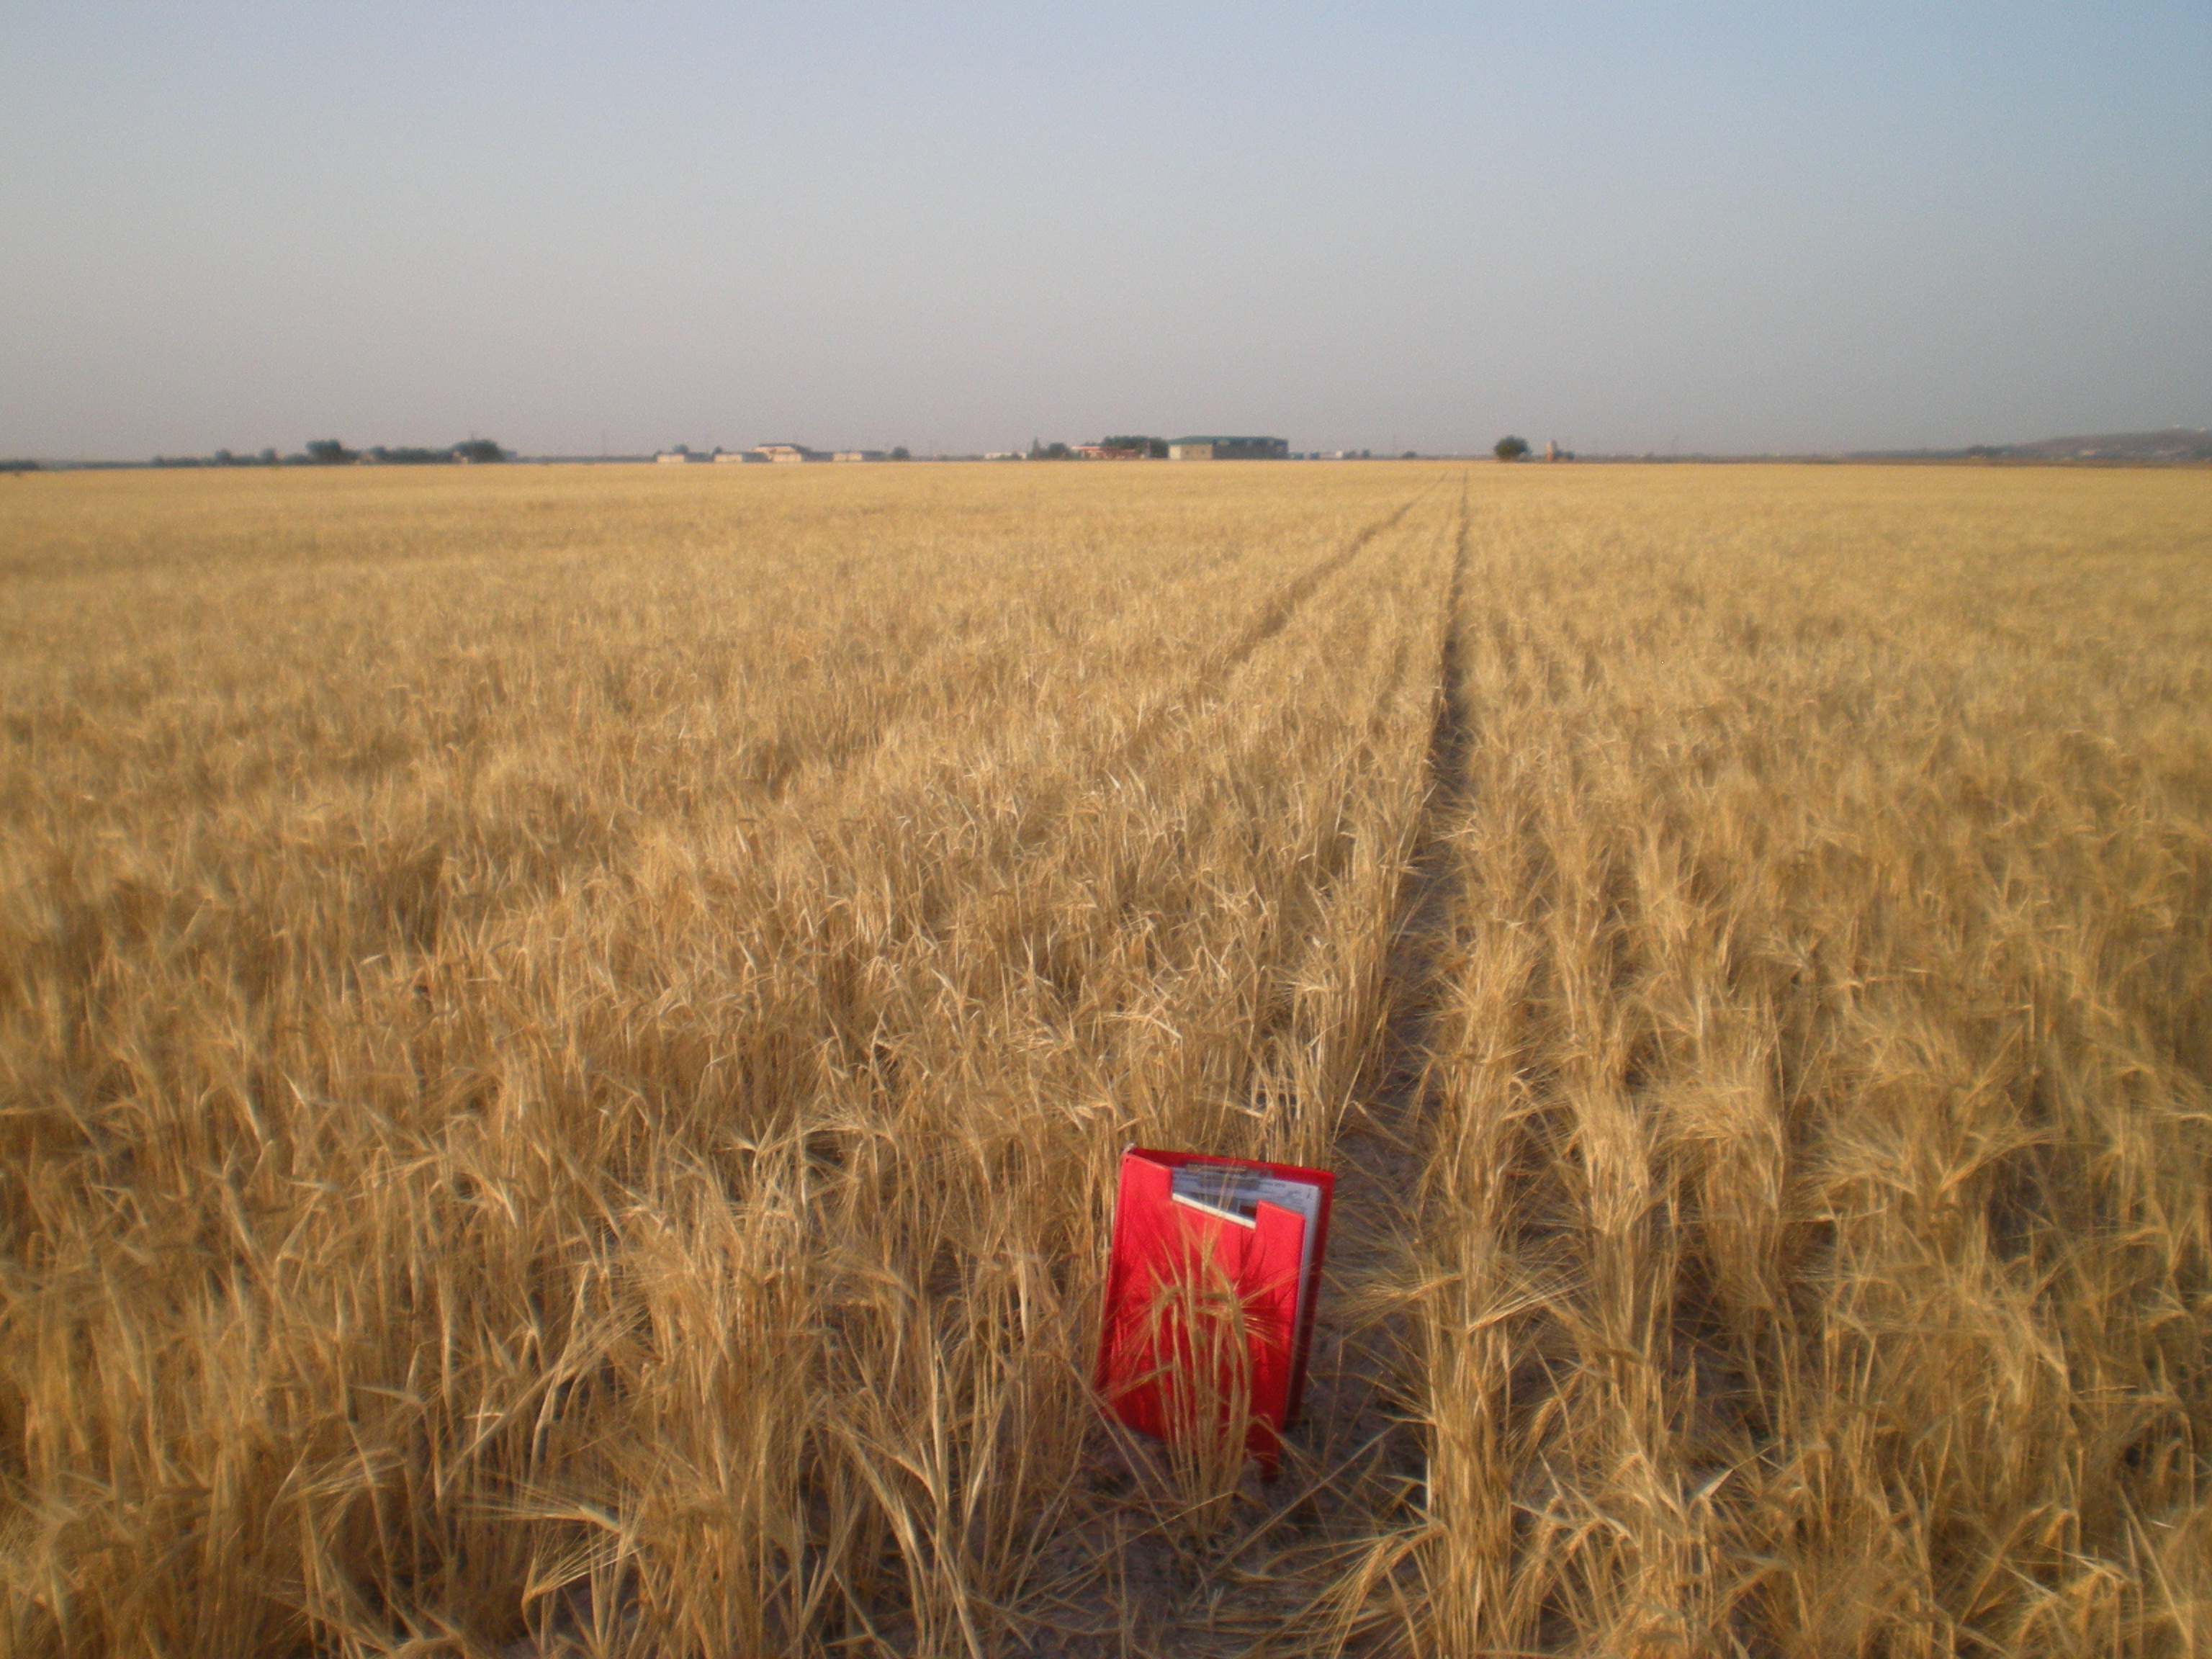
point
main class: Cropland
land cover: Barley
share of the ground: > 75 %
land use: Agriculture (excluding fallow land and kitchen gardens)
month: July
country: ES
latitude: 39.4278
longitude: -3.3210
